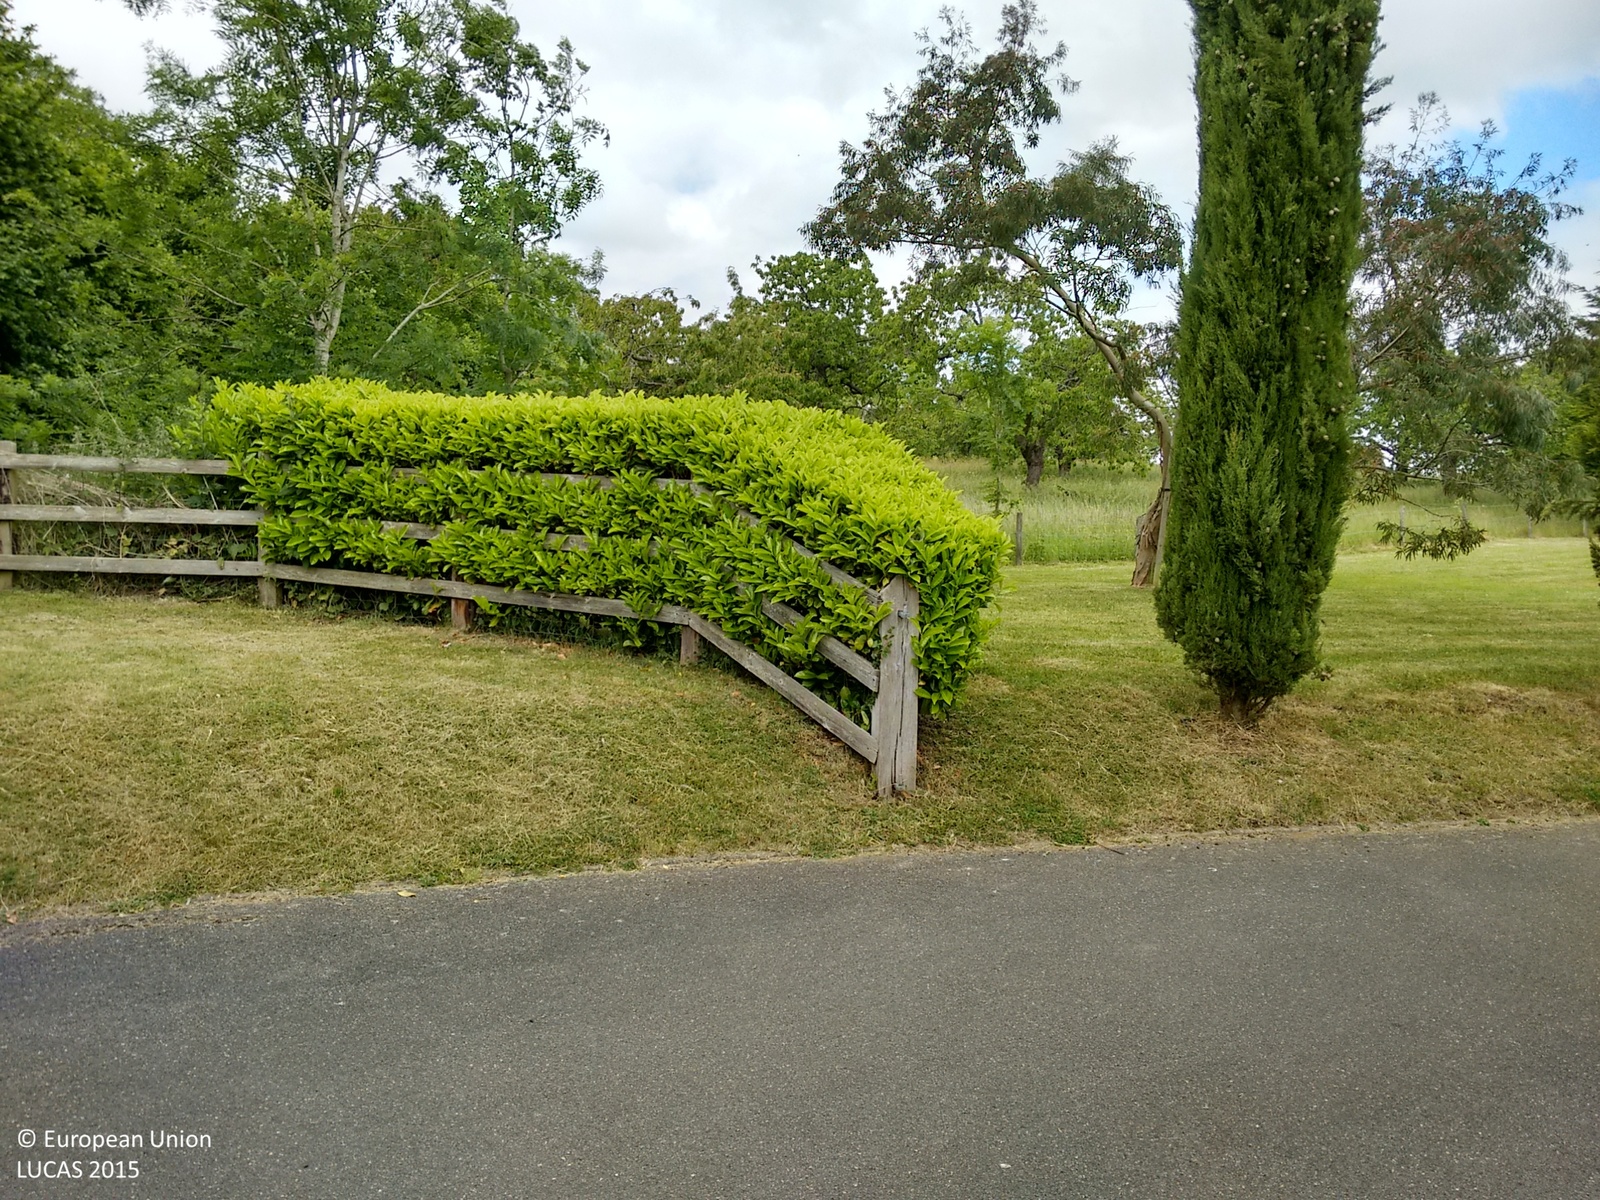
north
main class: Grassland
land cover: Grassland without tree/shrub cover
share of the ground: > 75 %
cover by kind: herbaceous plants 100 %
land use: Residential
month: June
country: GB
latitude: 51.5630
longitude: -0.7304
